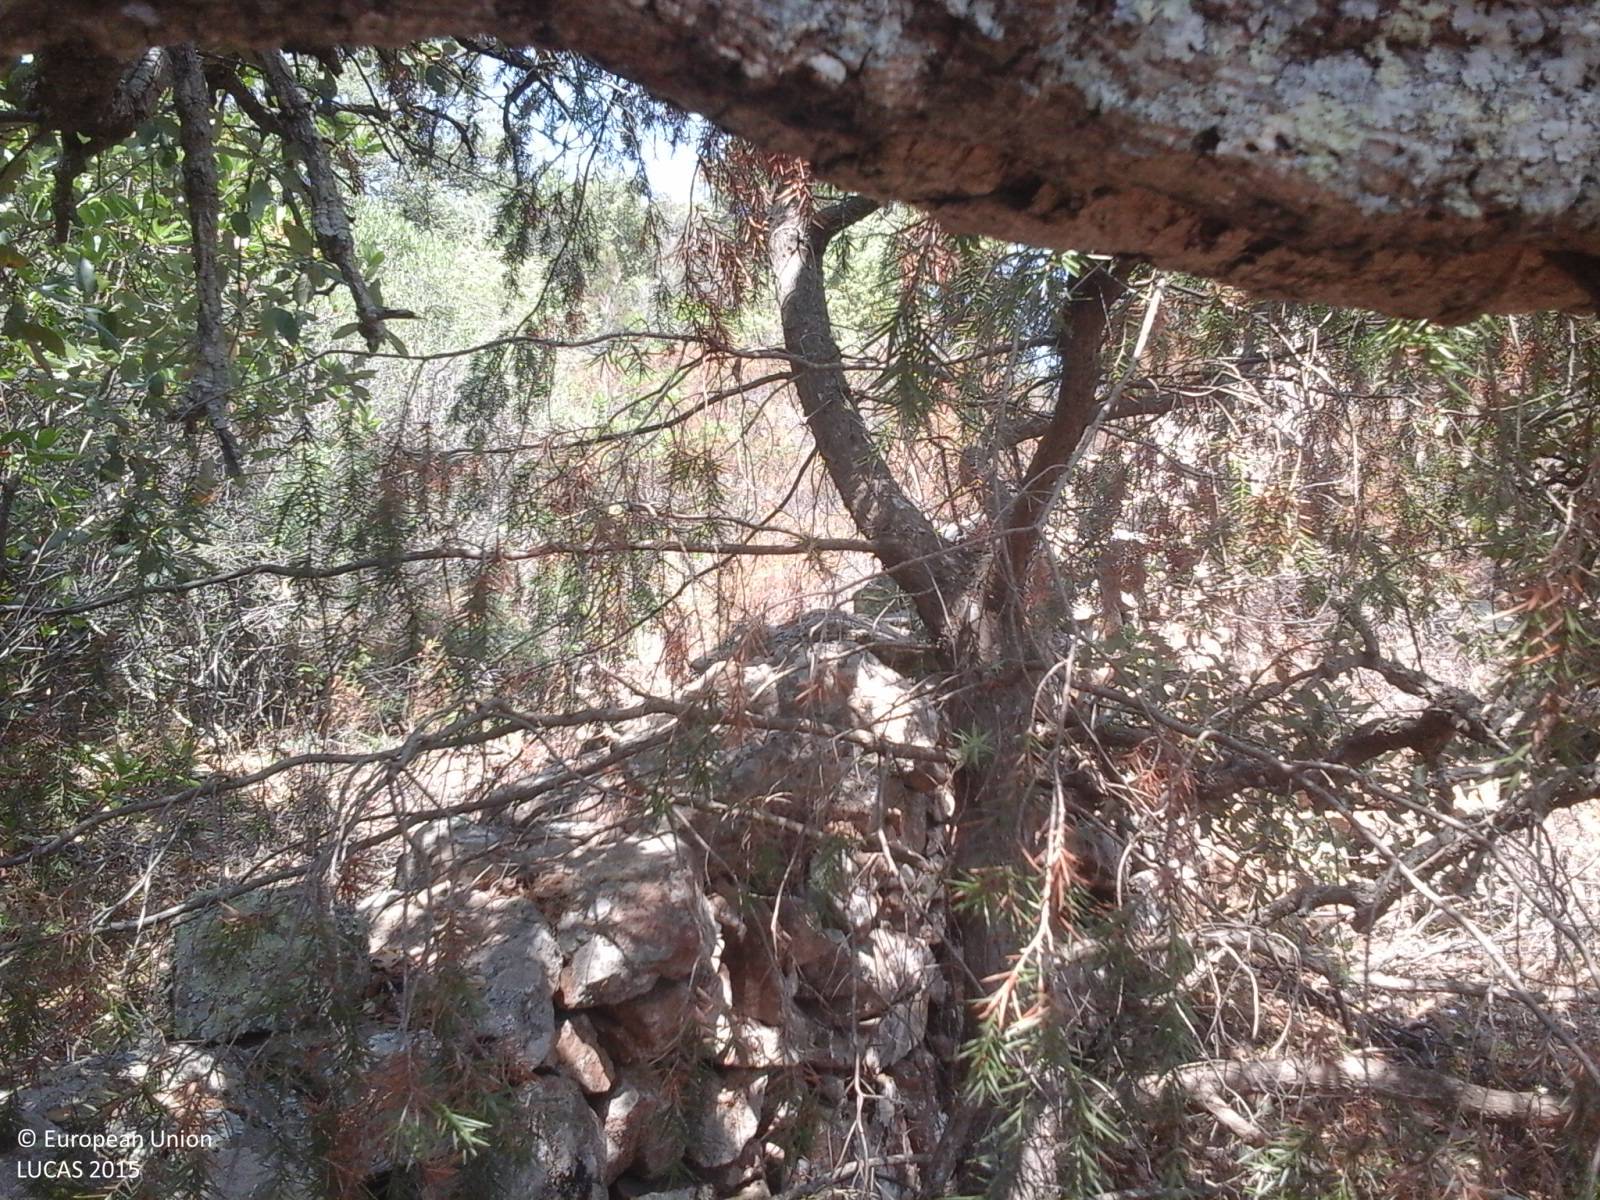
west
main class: Woodland
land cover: Broadleaved woodland
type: broadleaved evergreen forest
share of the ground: > 75 %
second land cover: Grassland without tree/shrub cover
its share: > 75 %
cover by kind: broadleaved forest trees 90 %, herbaceous plants 5 %, unconsolidated bare surface 5 %
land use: Forestry
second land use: Agriculture (excluding fallow land and kitchen gardens)
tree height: > 5 m
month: July
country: IT
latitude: 40.7912
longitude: 9.5636
